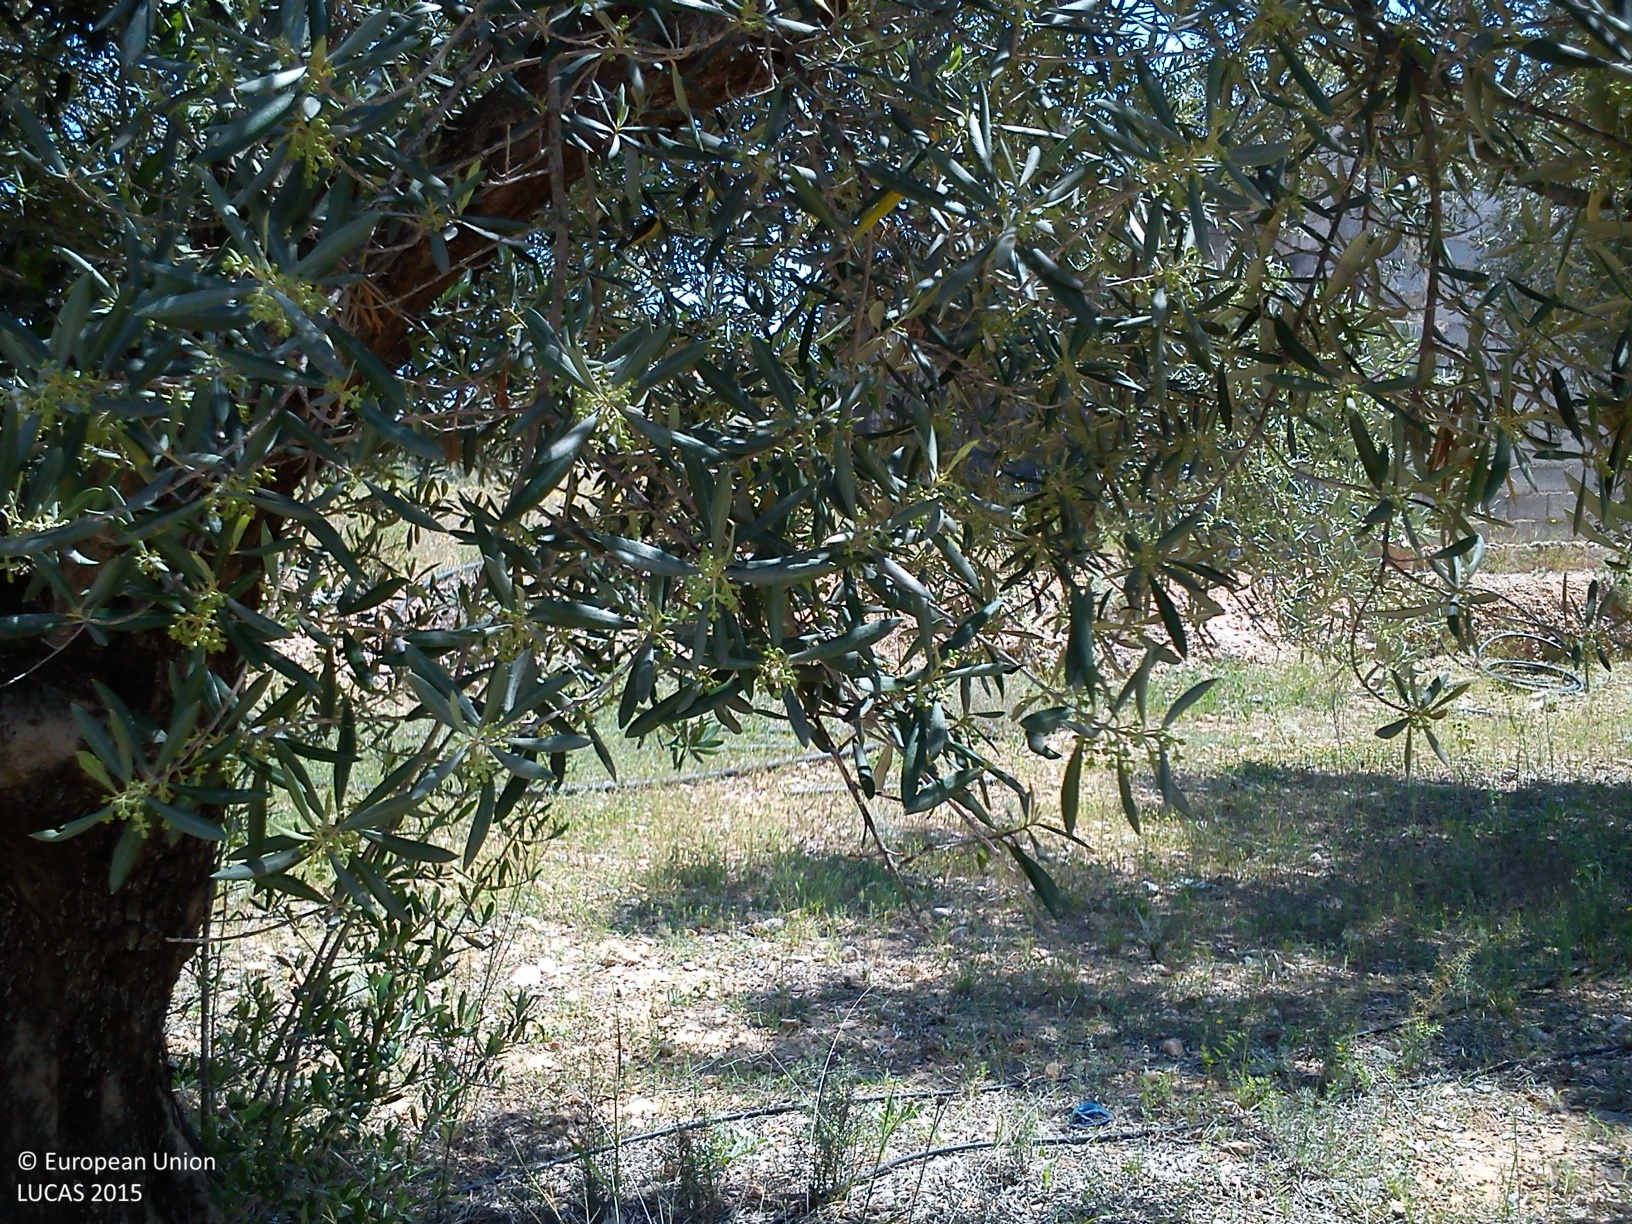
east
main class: Cropland
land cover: Olive groves
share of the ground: 25 - 50 %
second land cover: Spontaneously vegetated surfaces
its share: 25 - 50 %
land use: Agriculture (excluding fallow land and kitchen gardens)
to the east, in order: Olive groves; Spontaneously vegetated surfaces; Single bushes/trees; Artificial constructions in urban areas; Tracks; Shrubland without tree cover; Tracks; Shrubland without tree cover; Grassland without tree/shrub cover; Spontaneously vegetated surfaces; Ditches and canals; Other fresh vegetables
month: April
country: ES
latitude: 39.6300
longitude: -0.6607
